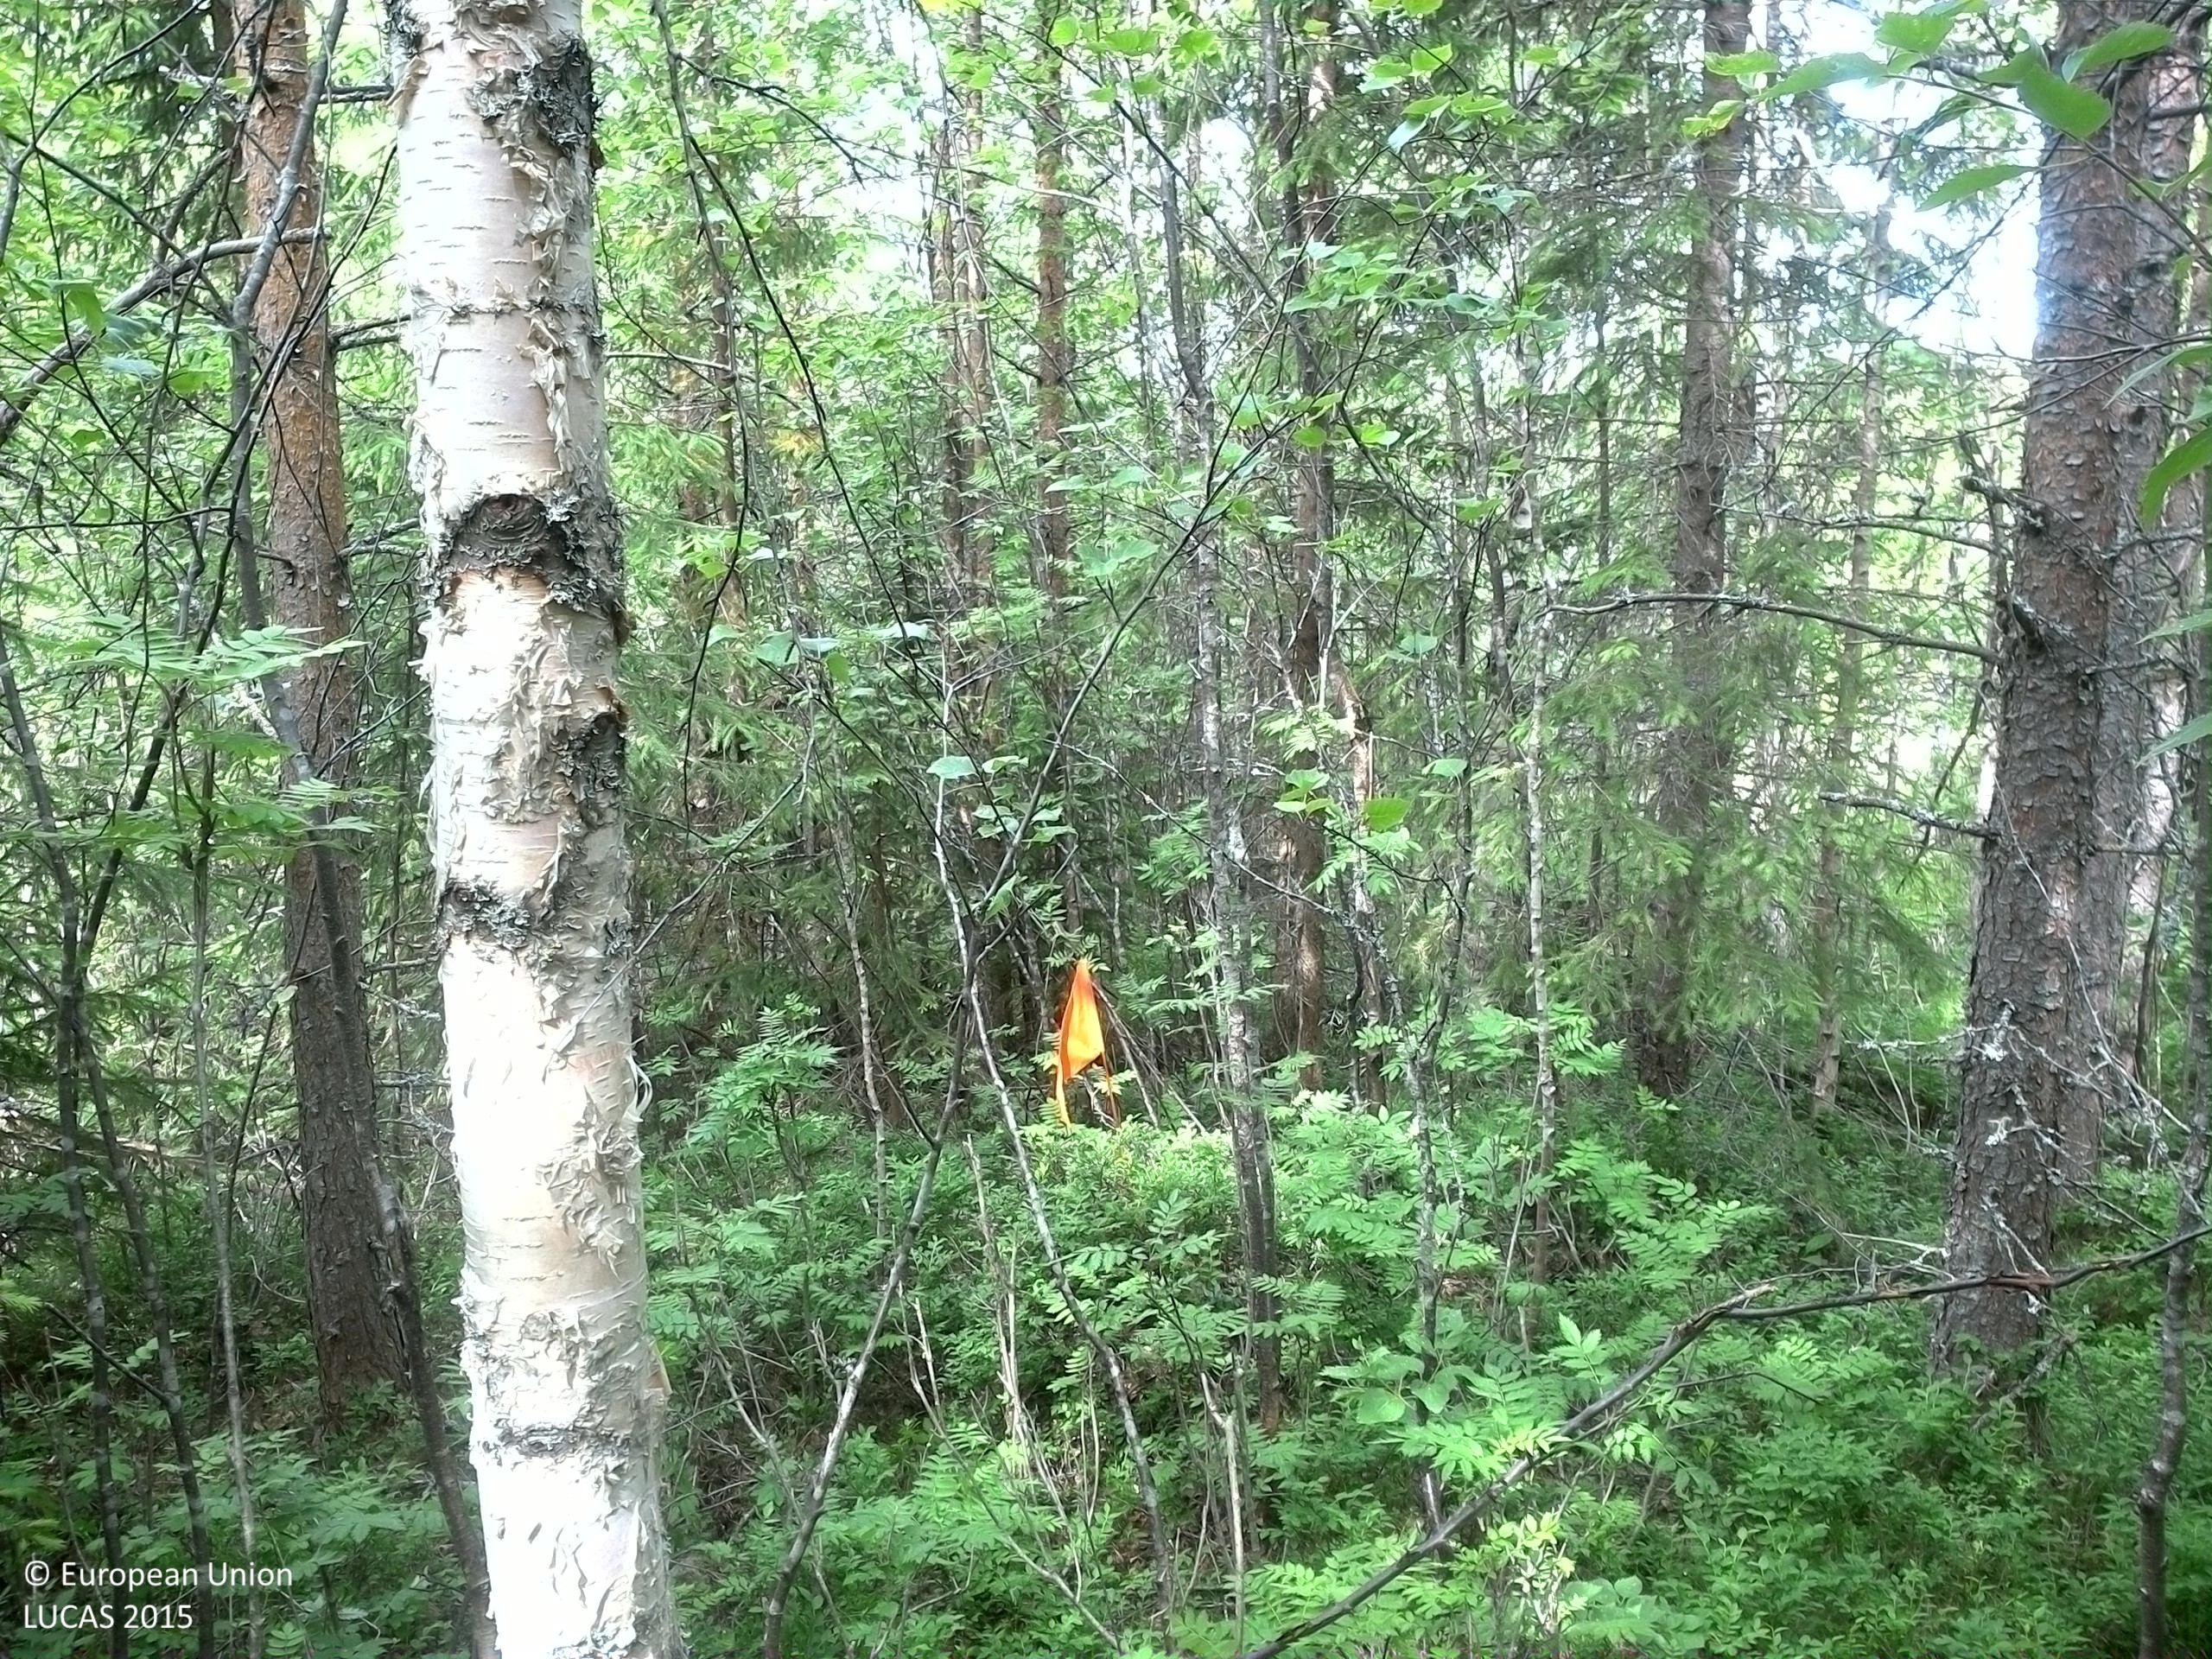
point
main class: Woodland
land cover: Spruce dominated mixed woodland
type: boreal forest
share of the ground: > 75 %
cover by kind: coniferous forest trees 60 %, broadleaved forest trees 20 %, shrubs 20 %
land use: Forestry
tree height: > 5 m
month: June
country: SE
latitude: 62.8683
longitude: 17.7028
